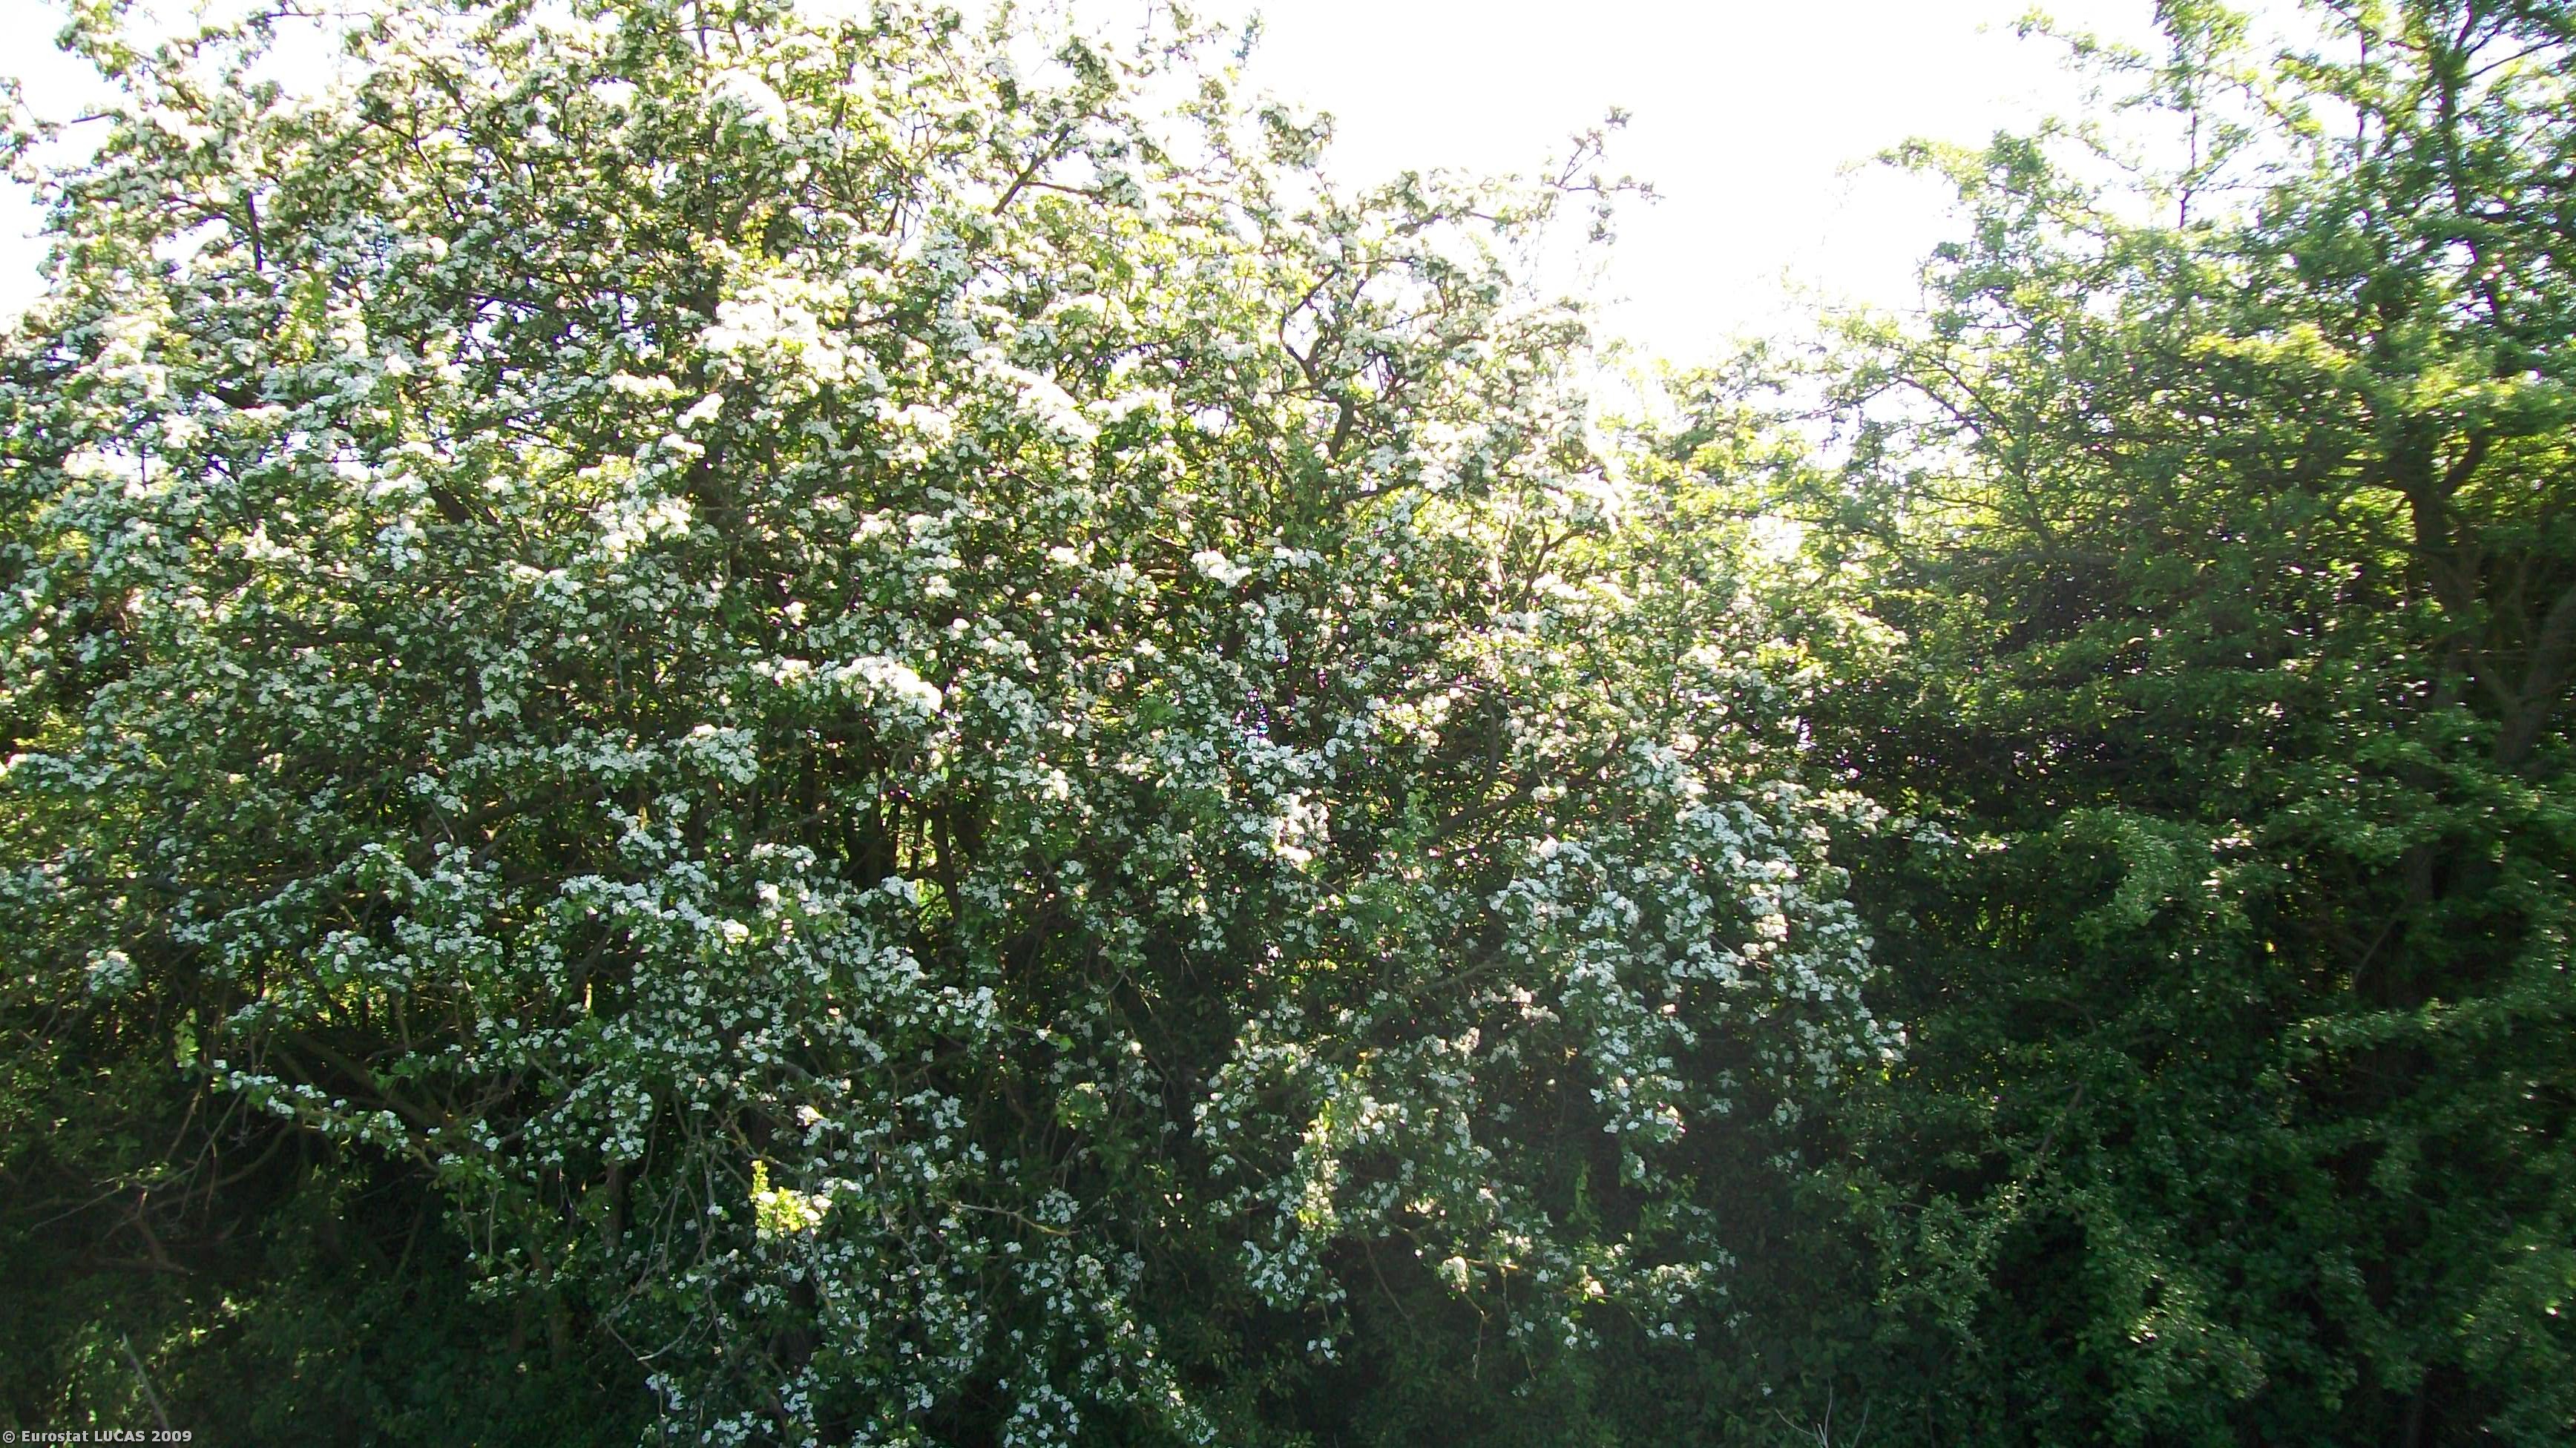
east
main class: Grassland
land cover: Grassland without tree/shrub cover
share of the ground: > 75 %
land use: Agriculture (excluding fallow land and kitchen gardens)
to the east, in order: Grassland without tree/shrub cover; Ditches and canals; Managed hedges; Grass margins; Barley; Managed hedges; Barley
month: May
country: GB
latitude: 53.1918
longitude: -2.8080
